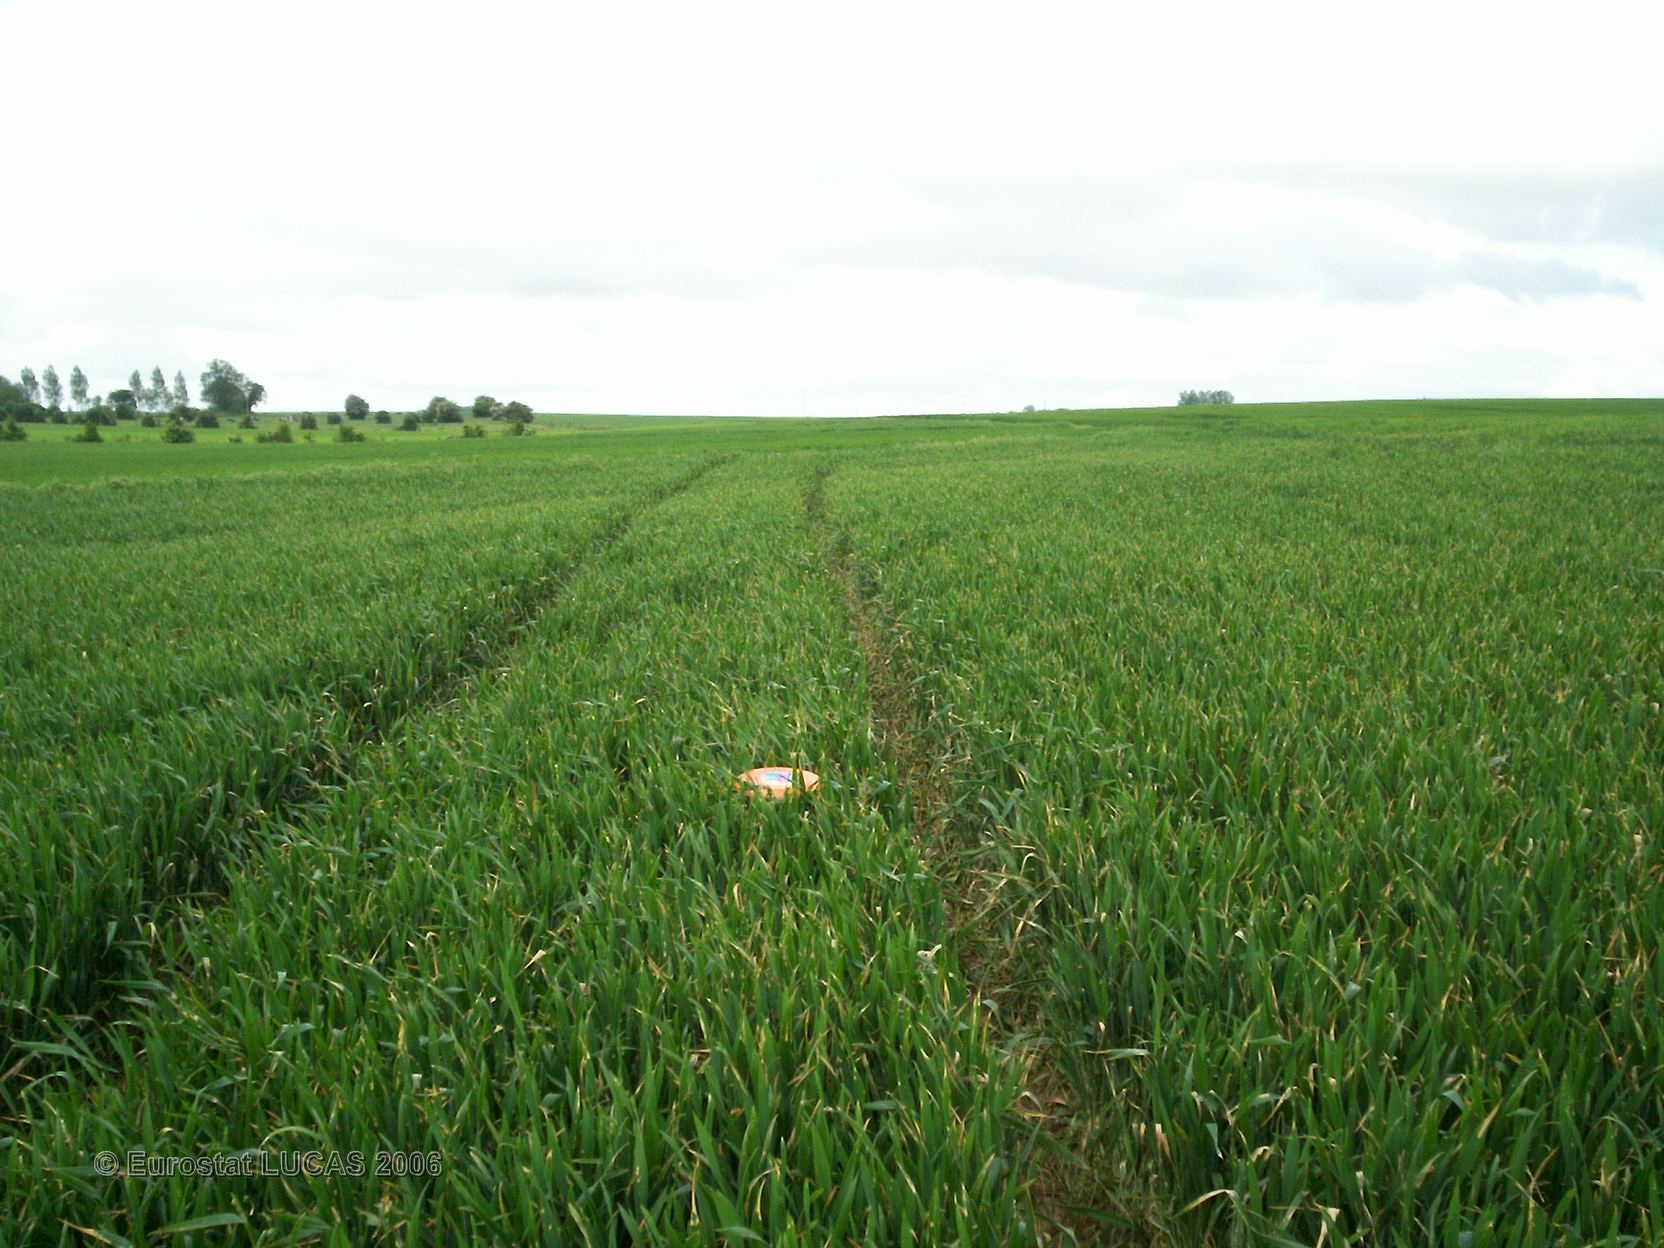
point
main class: Cropland
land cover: Common wheat
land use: Agriculture (excluding fallow land and kitchen gardens)
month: May
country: FR
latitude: 50.1110
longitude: 2.6752
